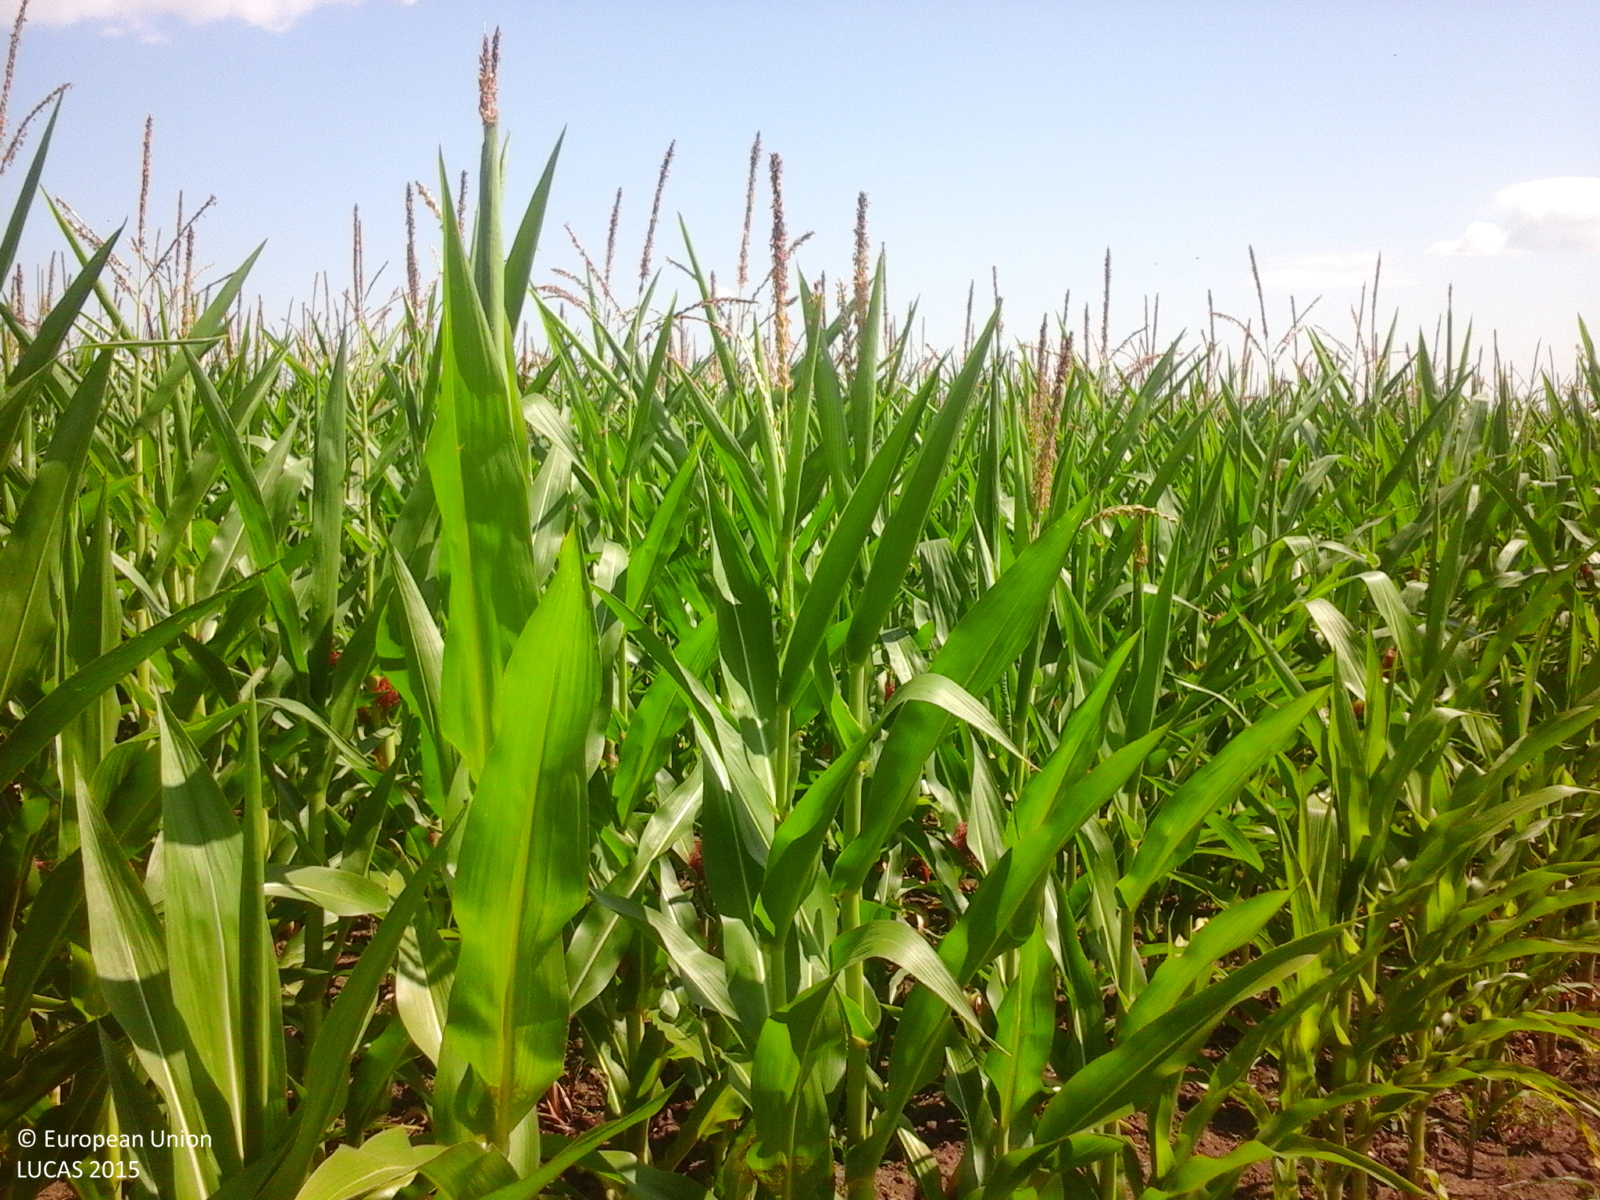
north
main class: Cropland
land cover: Maize
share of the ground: > 75 %
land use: Agriculture (excluding fallow land and kitchen gardens)
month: July
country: RO
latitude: 43.8943
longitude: 24.7473
